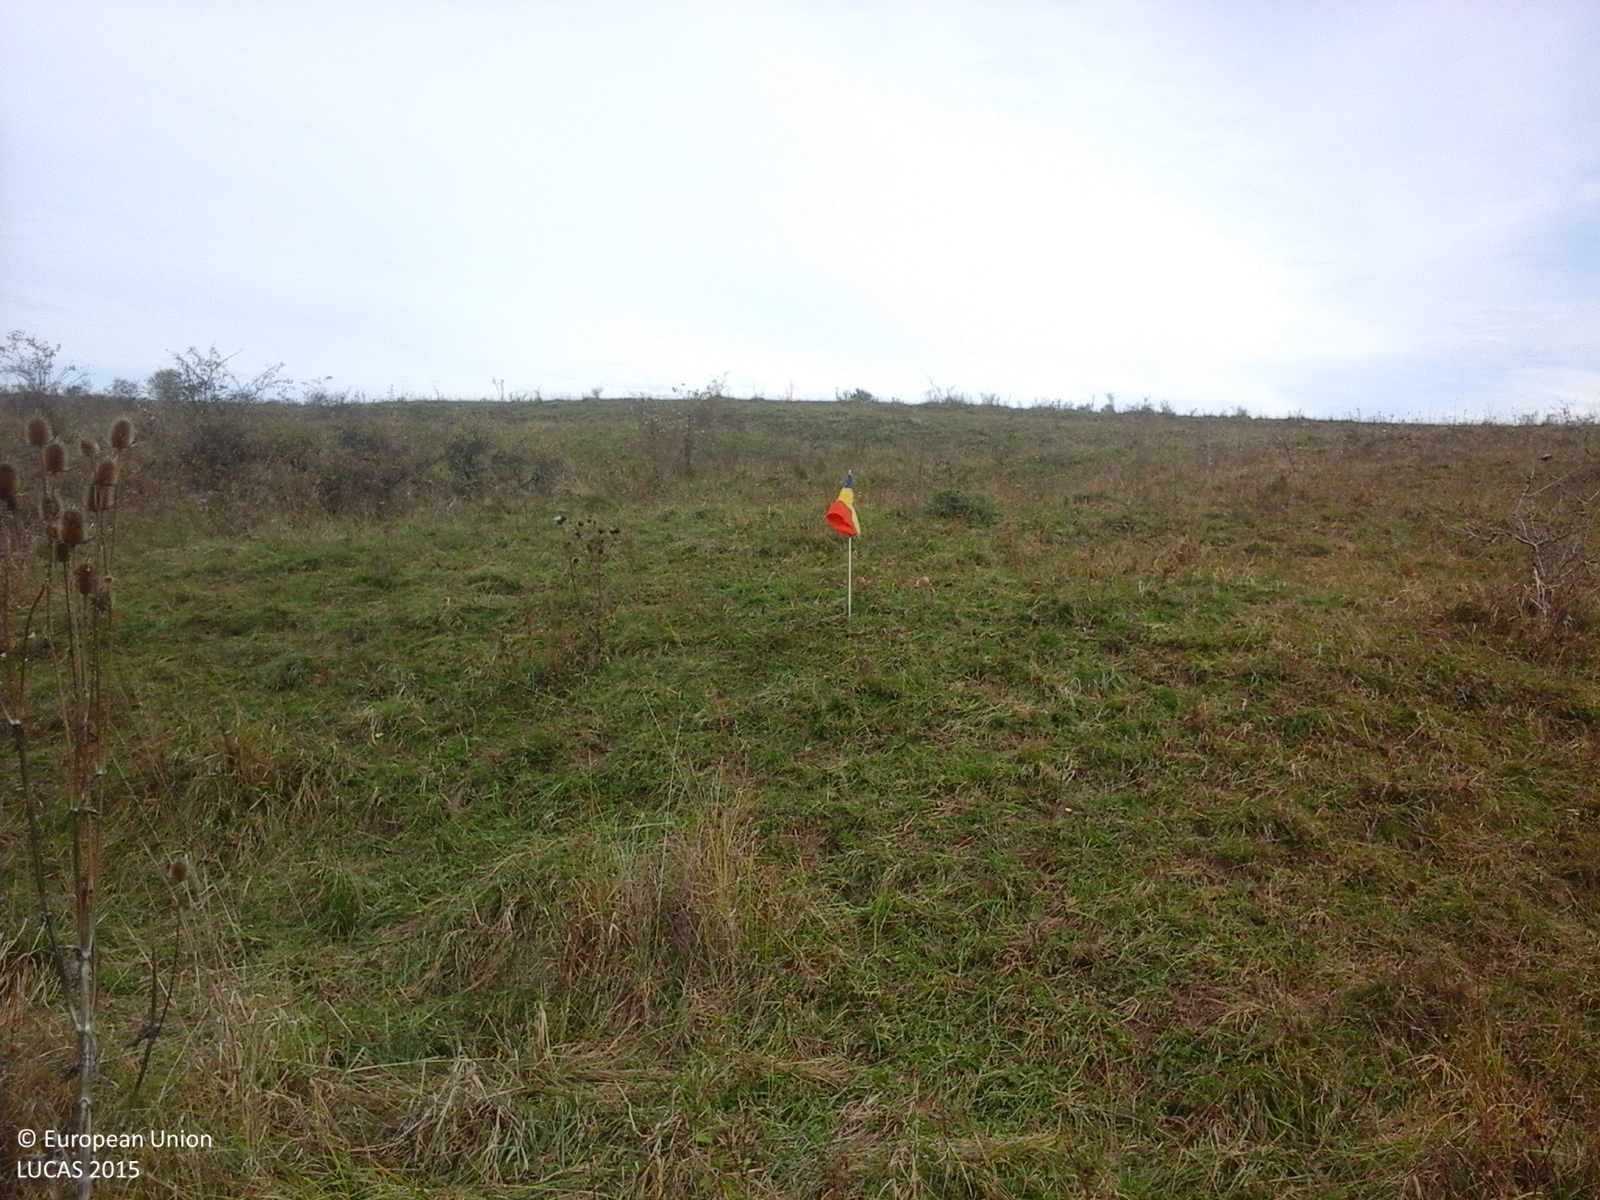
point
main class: Grassland
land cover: Spontaneously vegetated surfaces
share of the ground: > 75 %
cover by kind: herbaceous plants 100 %
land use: Fallow land
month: October
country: RO
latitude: 45.8612
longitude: 25.0740
